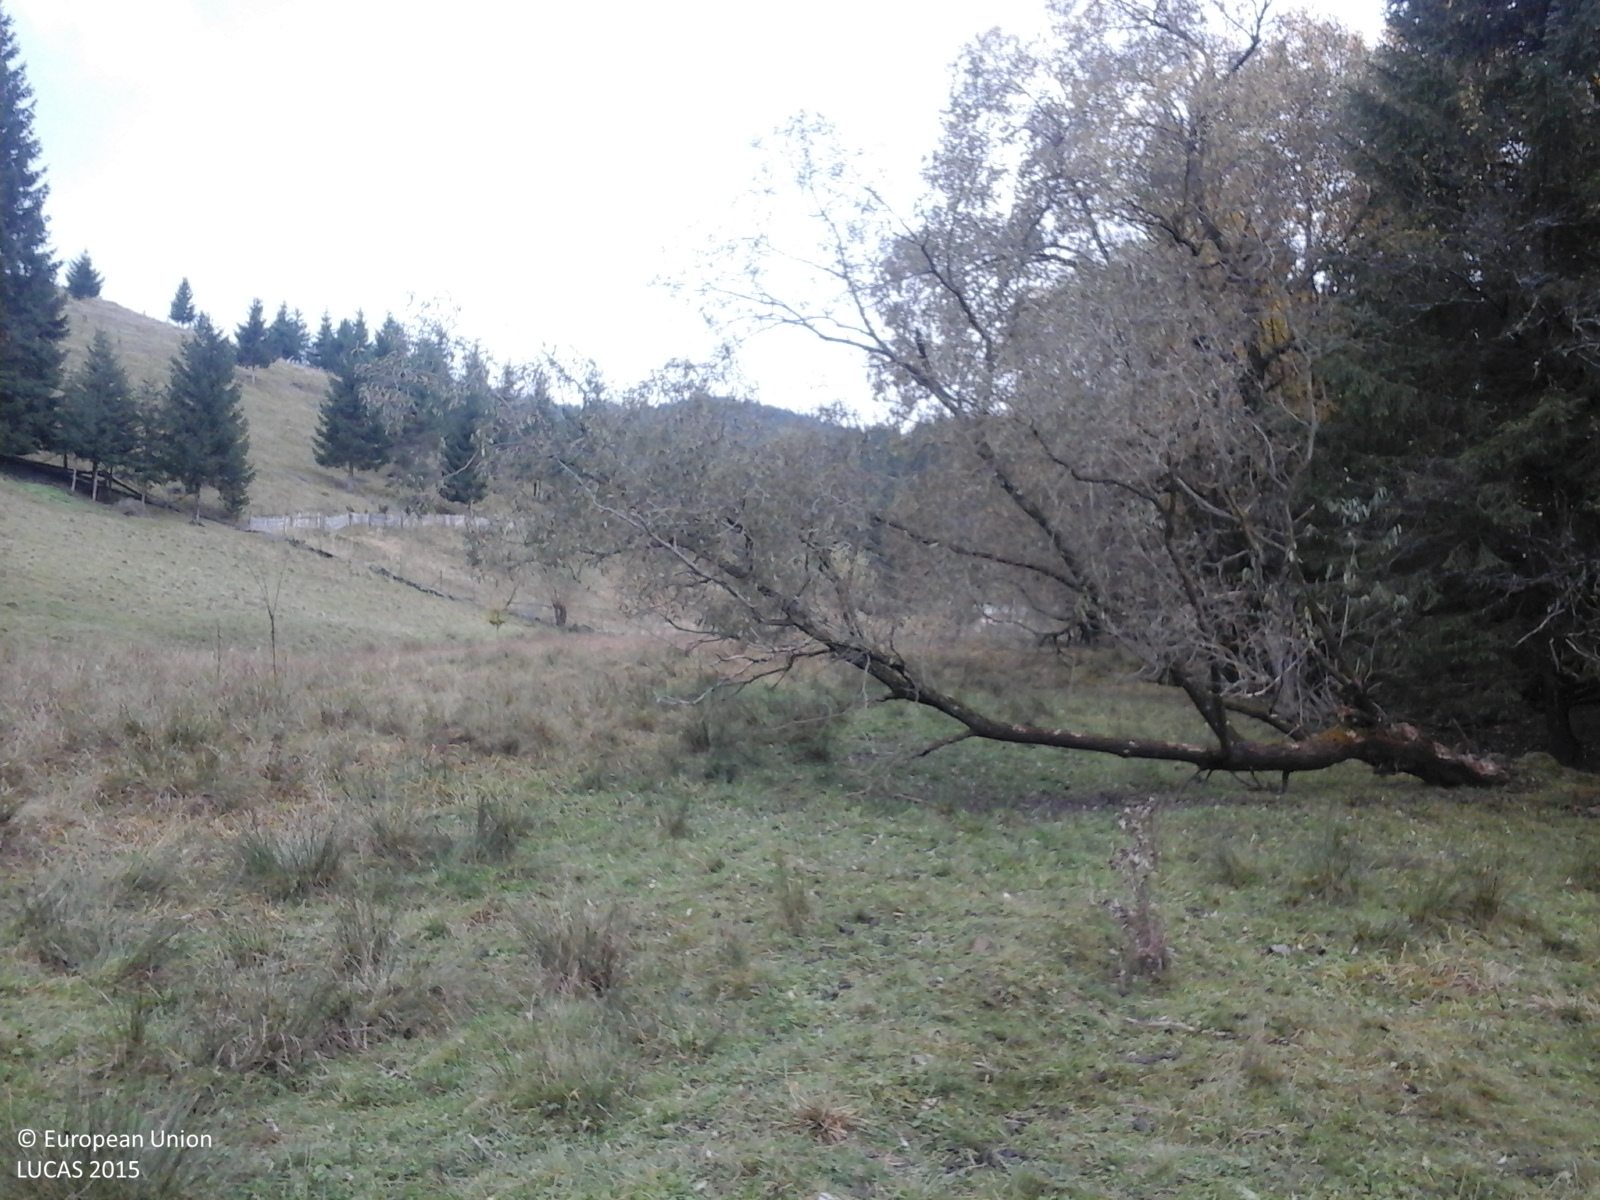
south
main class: Grassland
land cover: Grassland without tree/shrub cover
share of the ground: > 75 %
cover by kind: herbaceous plants 100 %
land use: Agriculture (excluding fallow land and kitchen gardens)
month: October
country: RO
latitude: 46.9701
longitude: 25.6385
